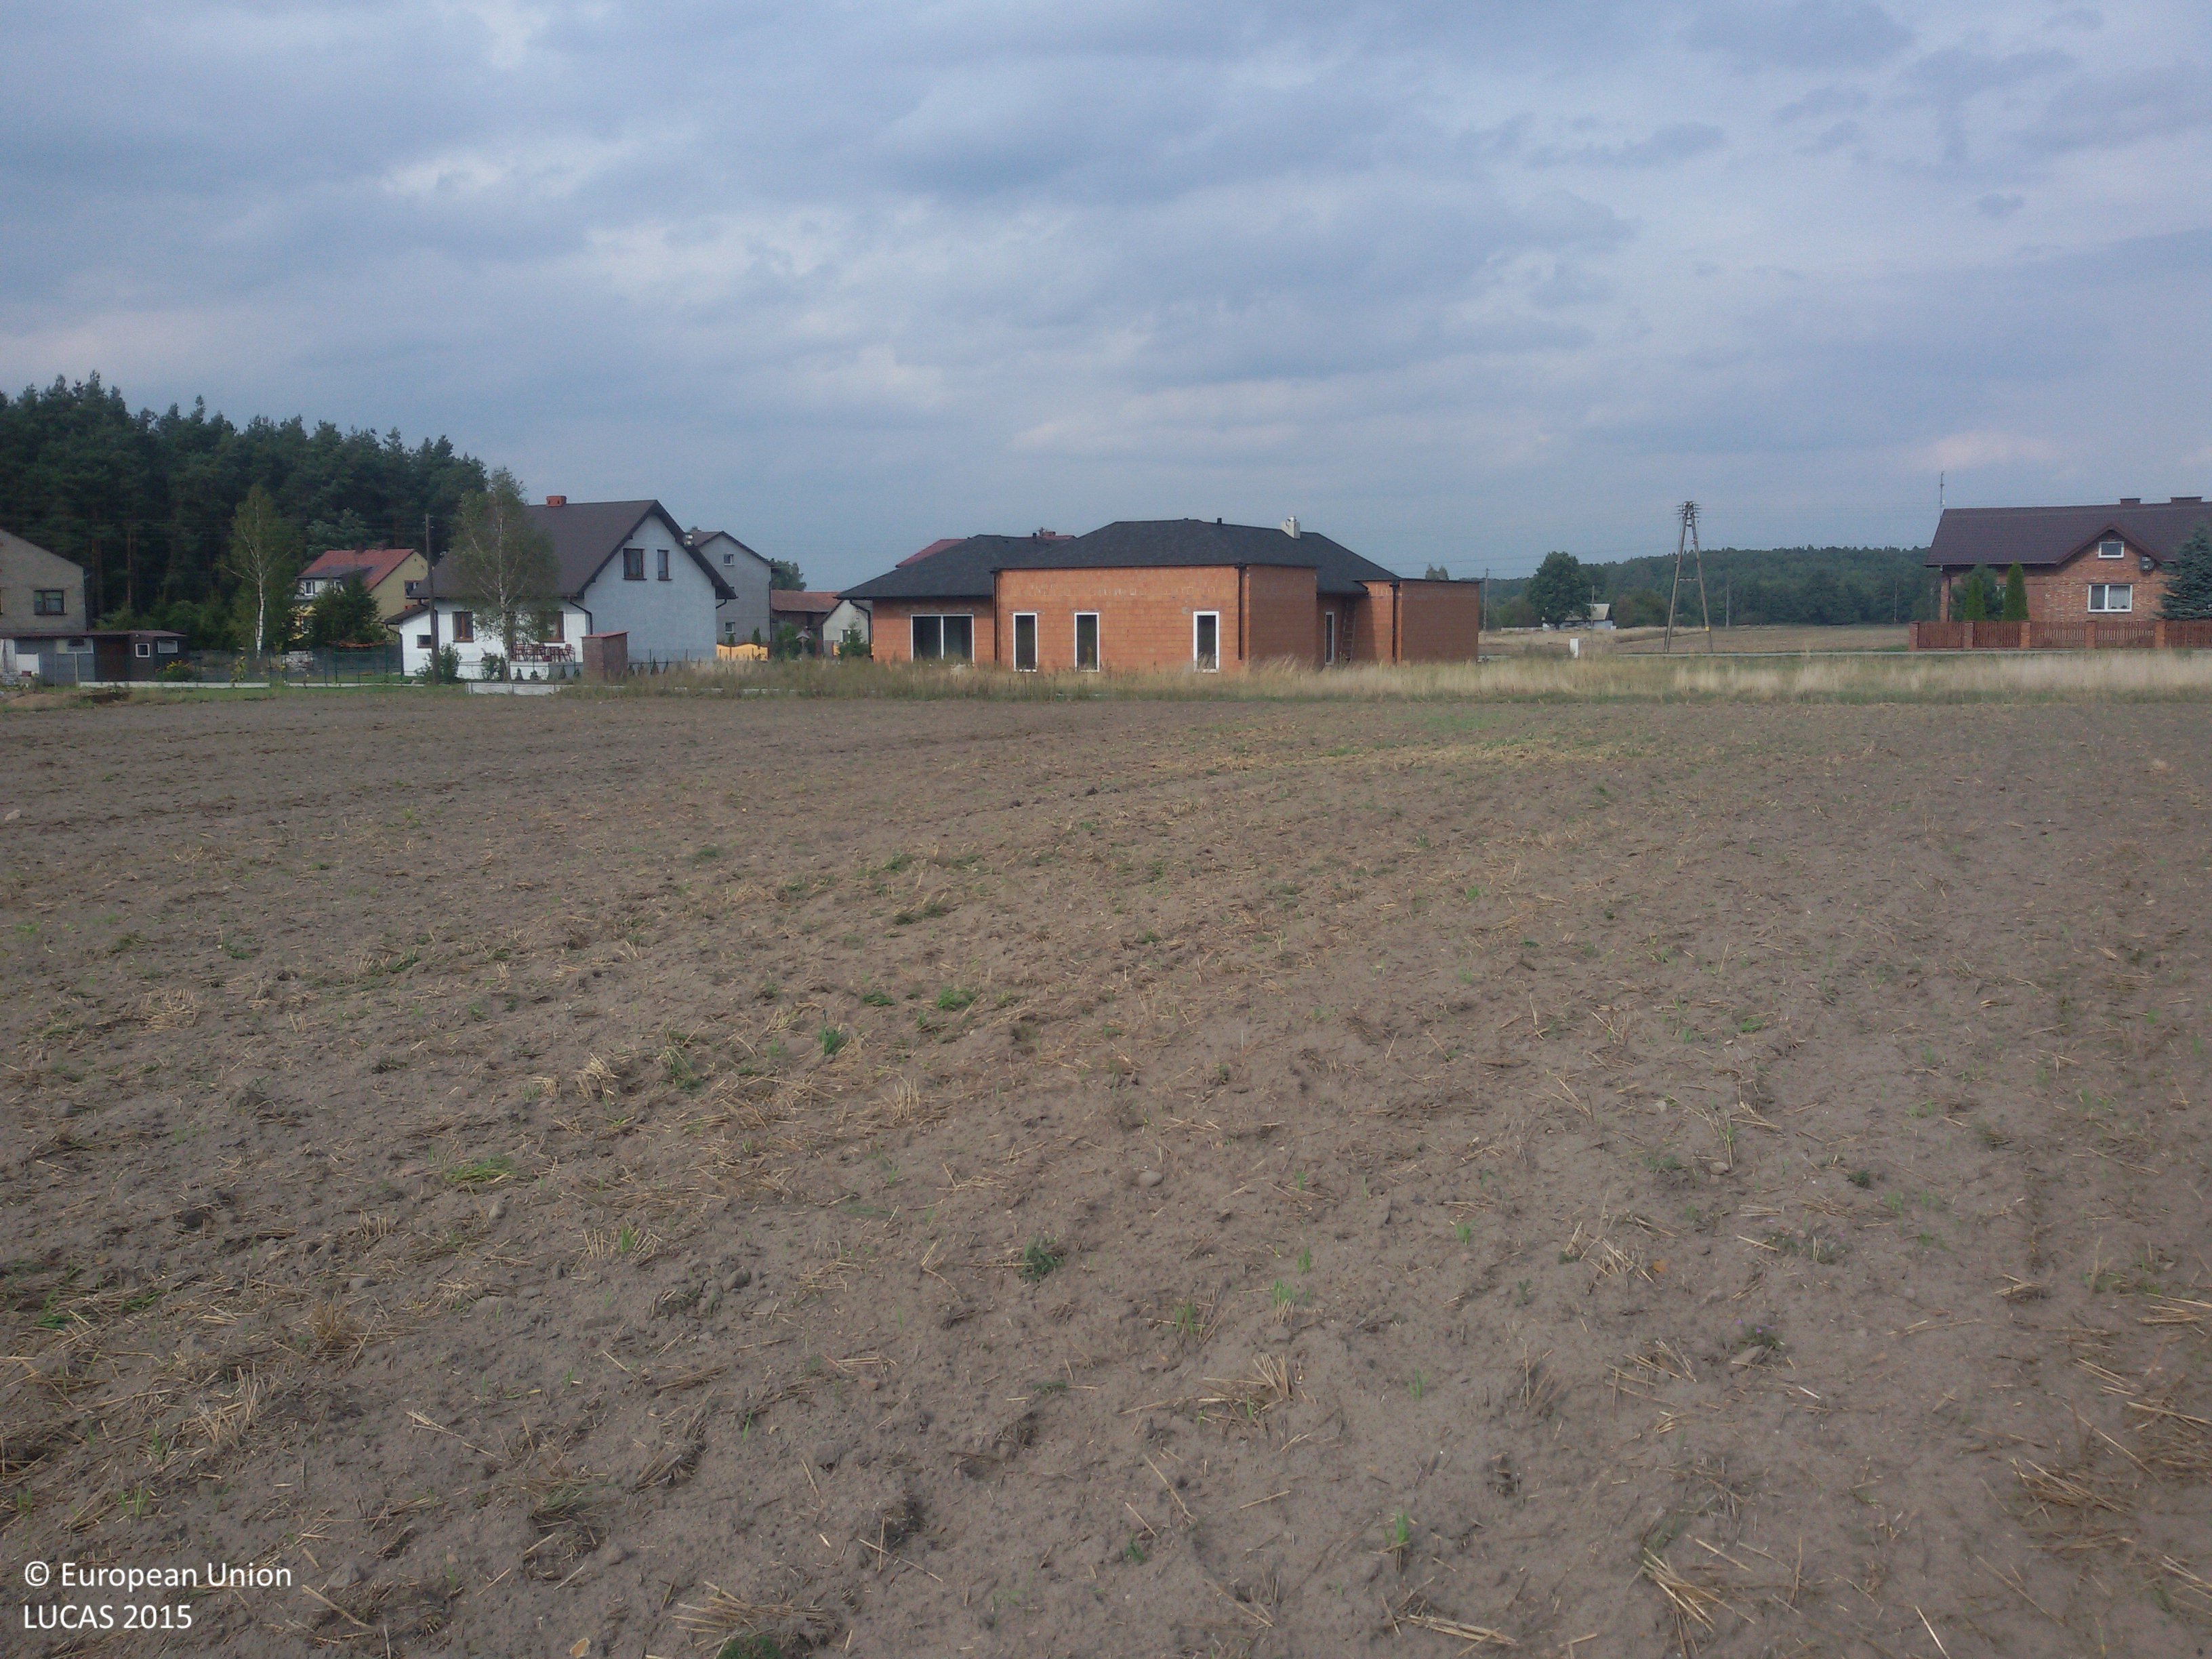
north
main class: Cropland
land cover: Common wheat
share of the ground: < 10 %
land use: Agriculture (excluding fallow land and kitchen gardens)
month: September
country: PL
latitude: 50.8953
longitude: 18.7653
